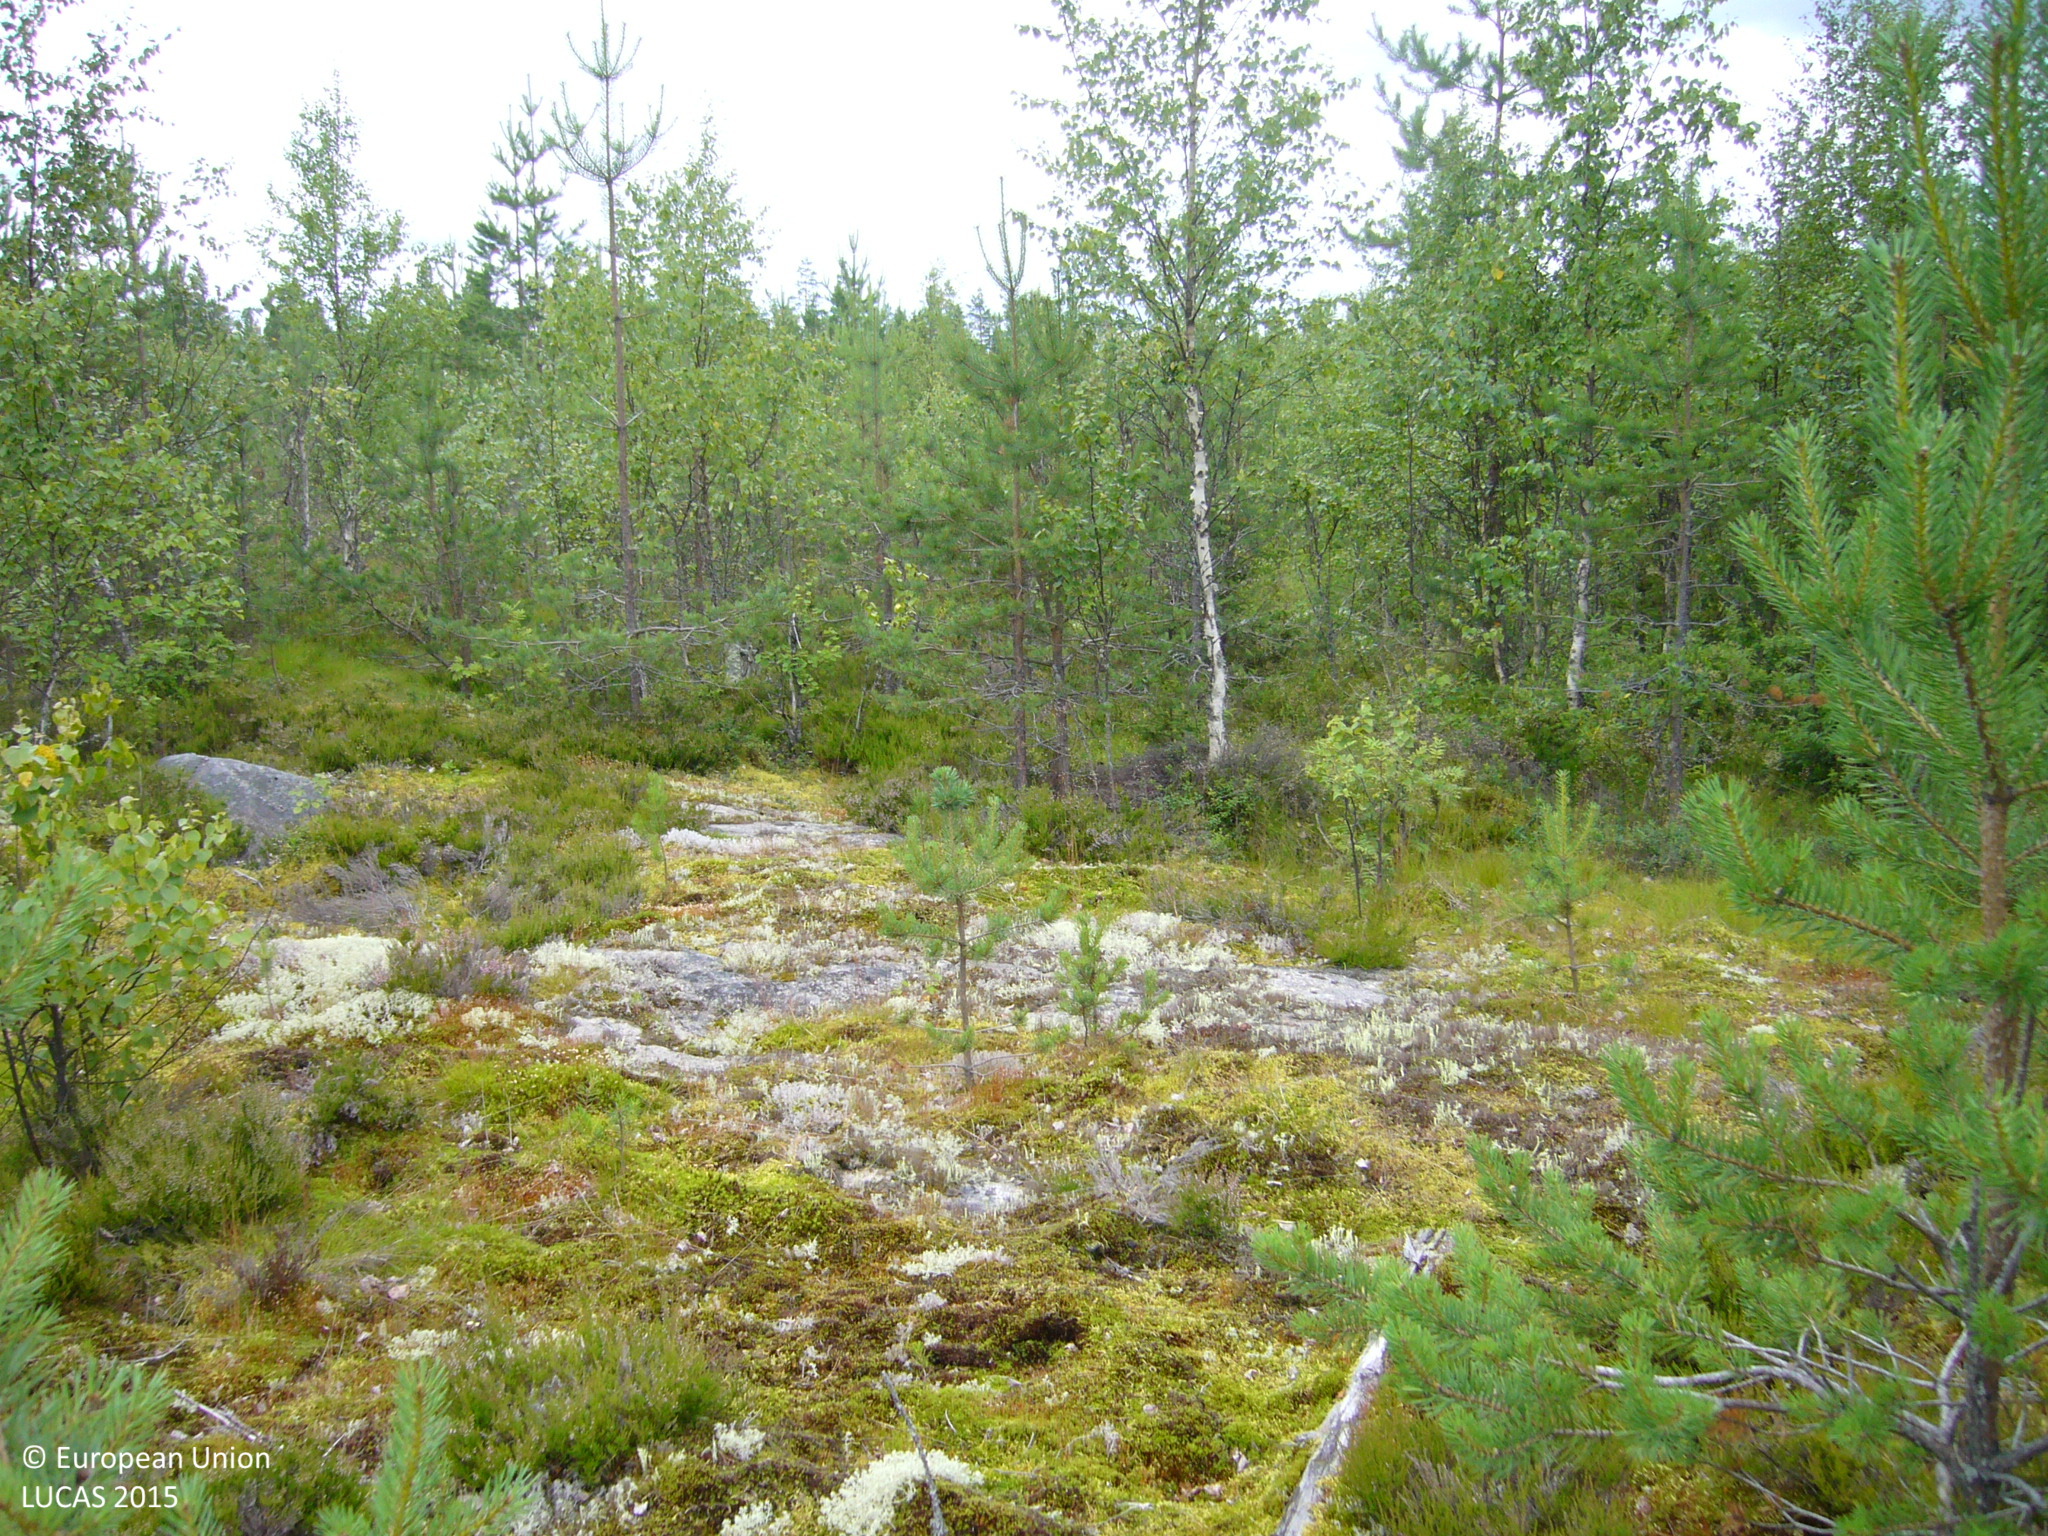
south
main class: Woodland
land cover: Pine dominated mixed woodland
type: boreal forest
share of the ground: 50 - 75 %
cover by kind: coniferous forest trees 30 %, lichens and mosses 30 %, broadleaved forest trees 20 %, consolidated bare surface 20 %
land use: Forestry
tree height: < 5 m
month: July
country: FI
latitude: 63.9447
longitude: 26.2139
